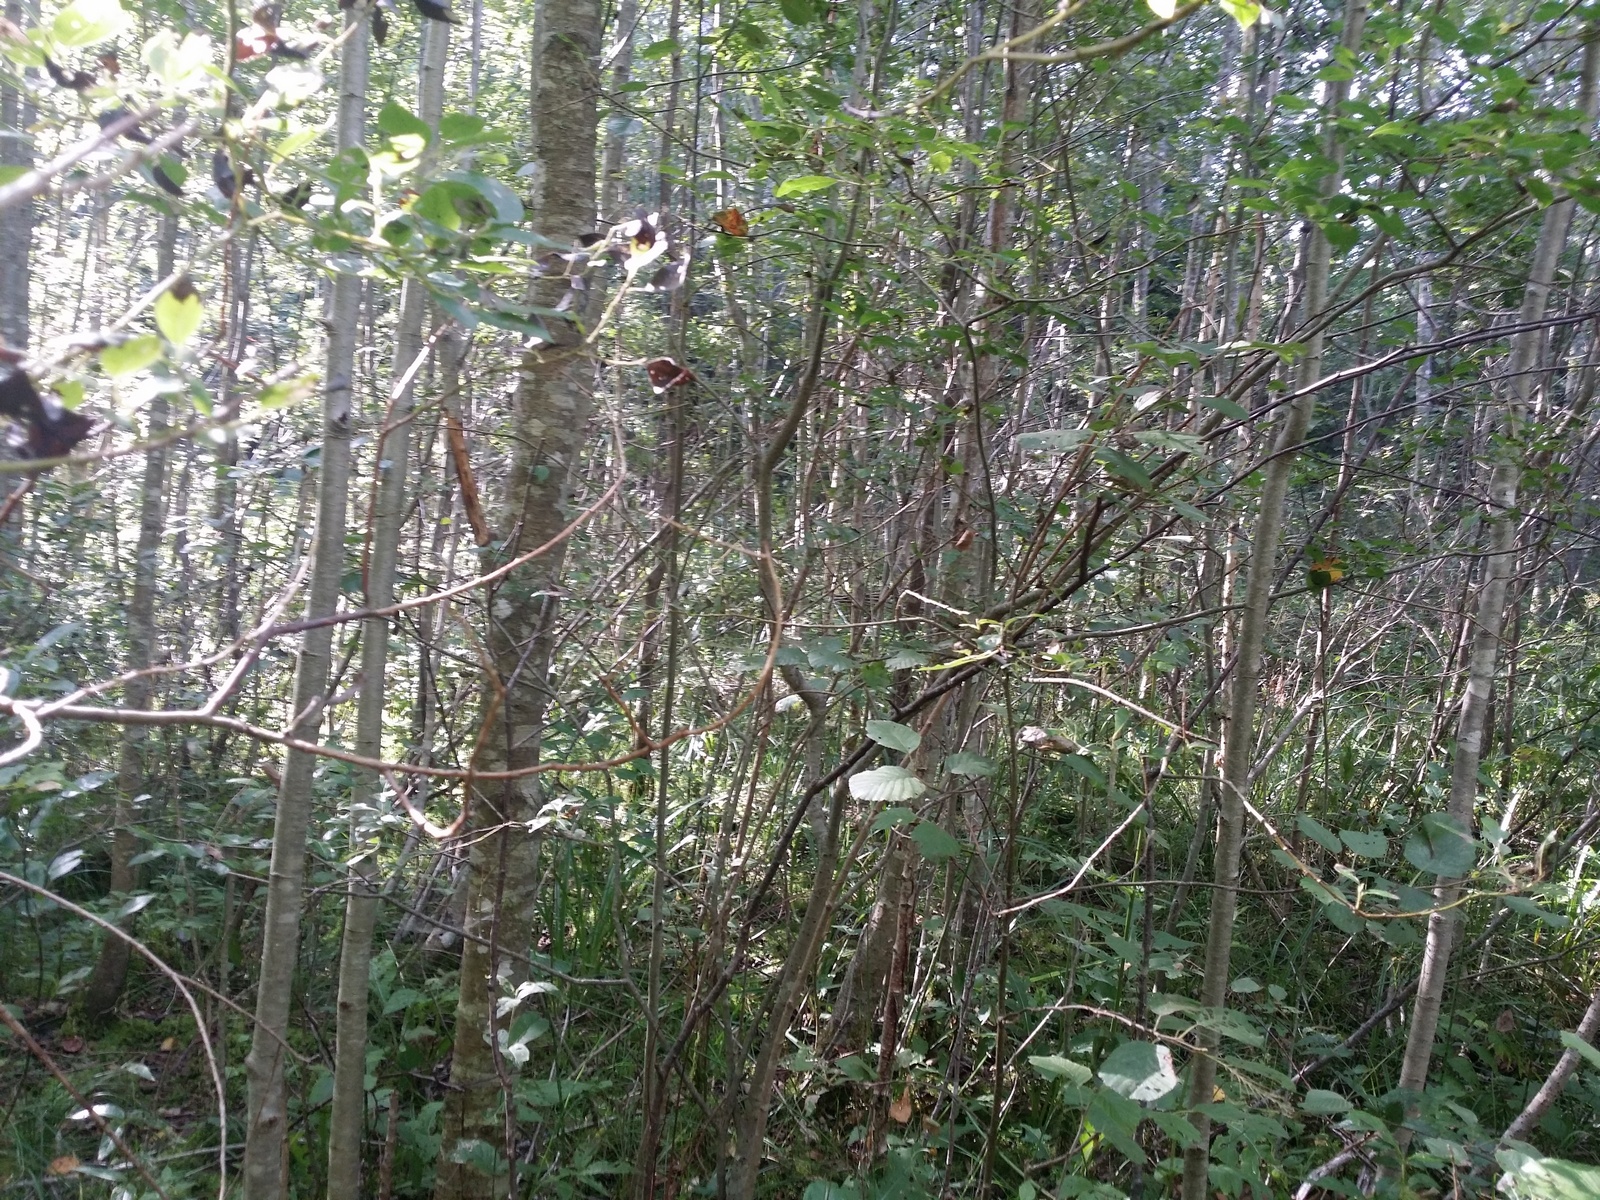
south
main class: Woodland
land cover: Broadleaved woodland
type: non-riverine alder, birch or aspen forest
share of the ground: > 75 %
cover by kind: broadleaved forest trees 85 %, herbaceous plants 15 %
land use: Semi-natural and natural areas not in use
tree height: < 5 m
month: August
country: LV
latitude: 57.5065
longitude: 26.8947
